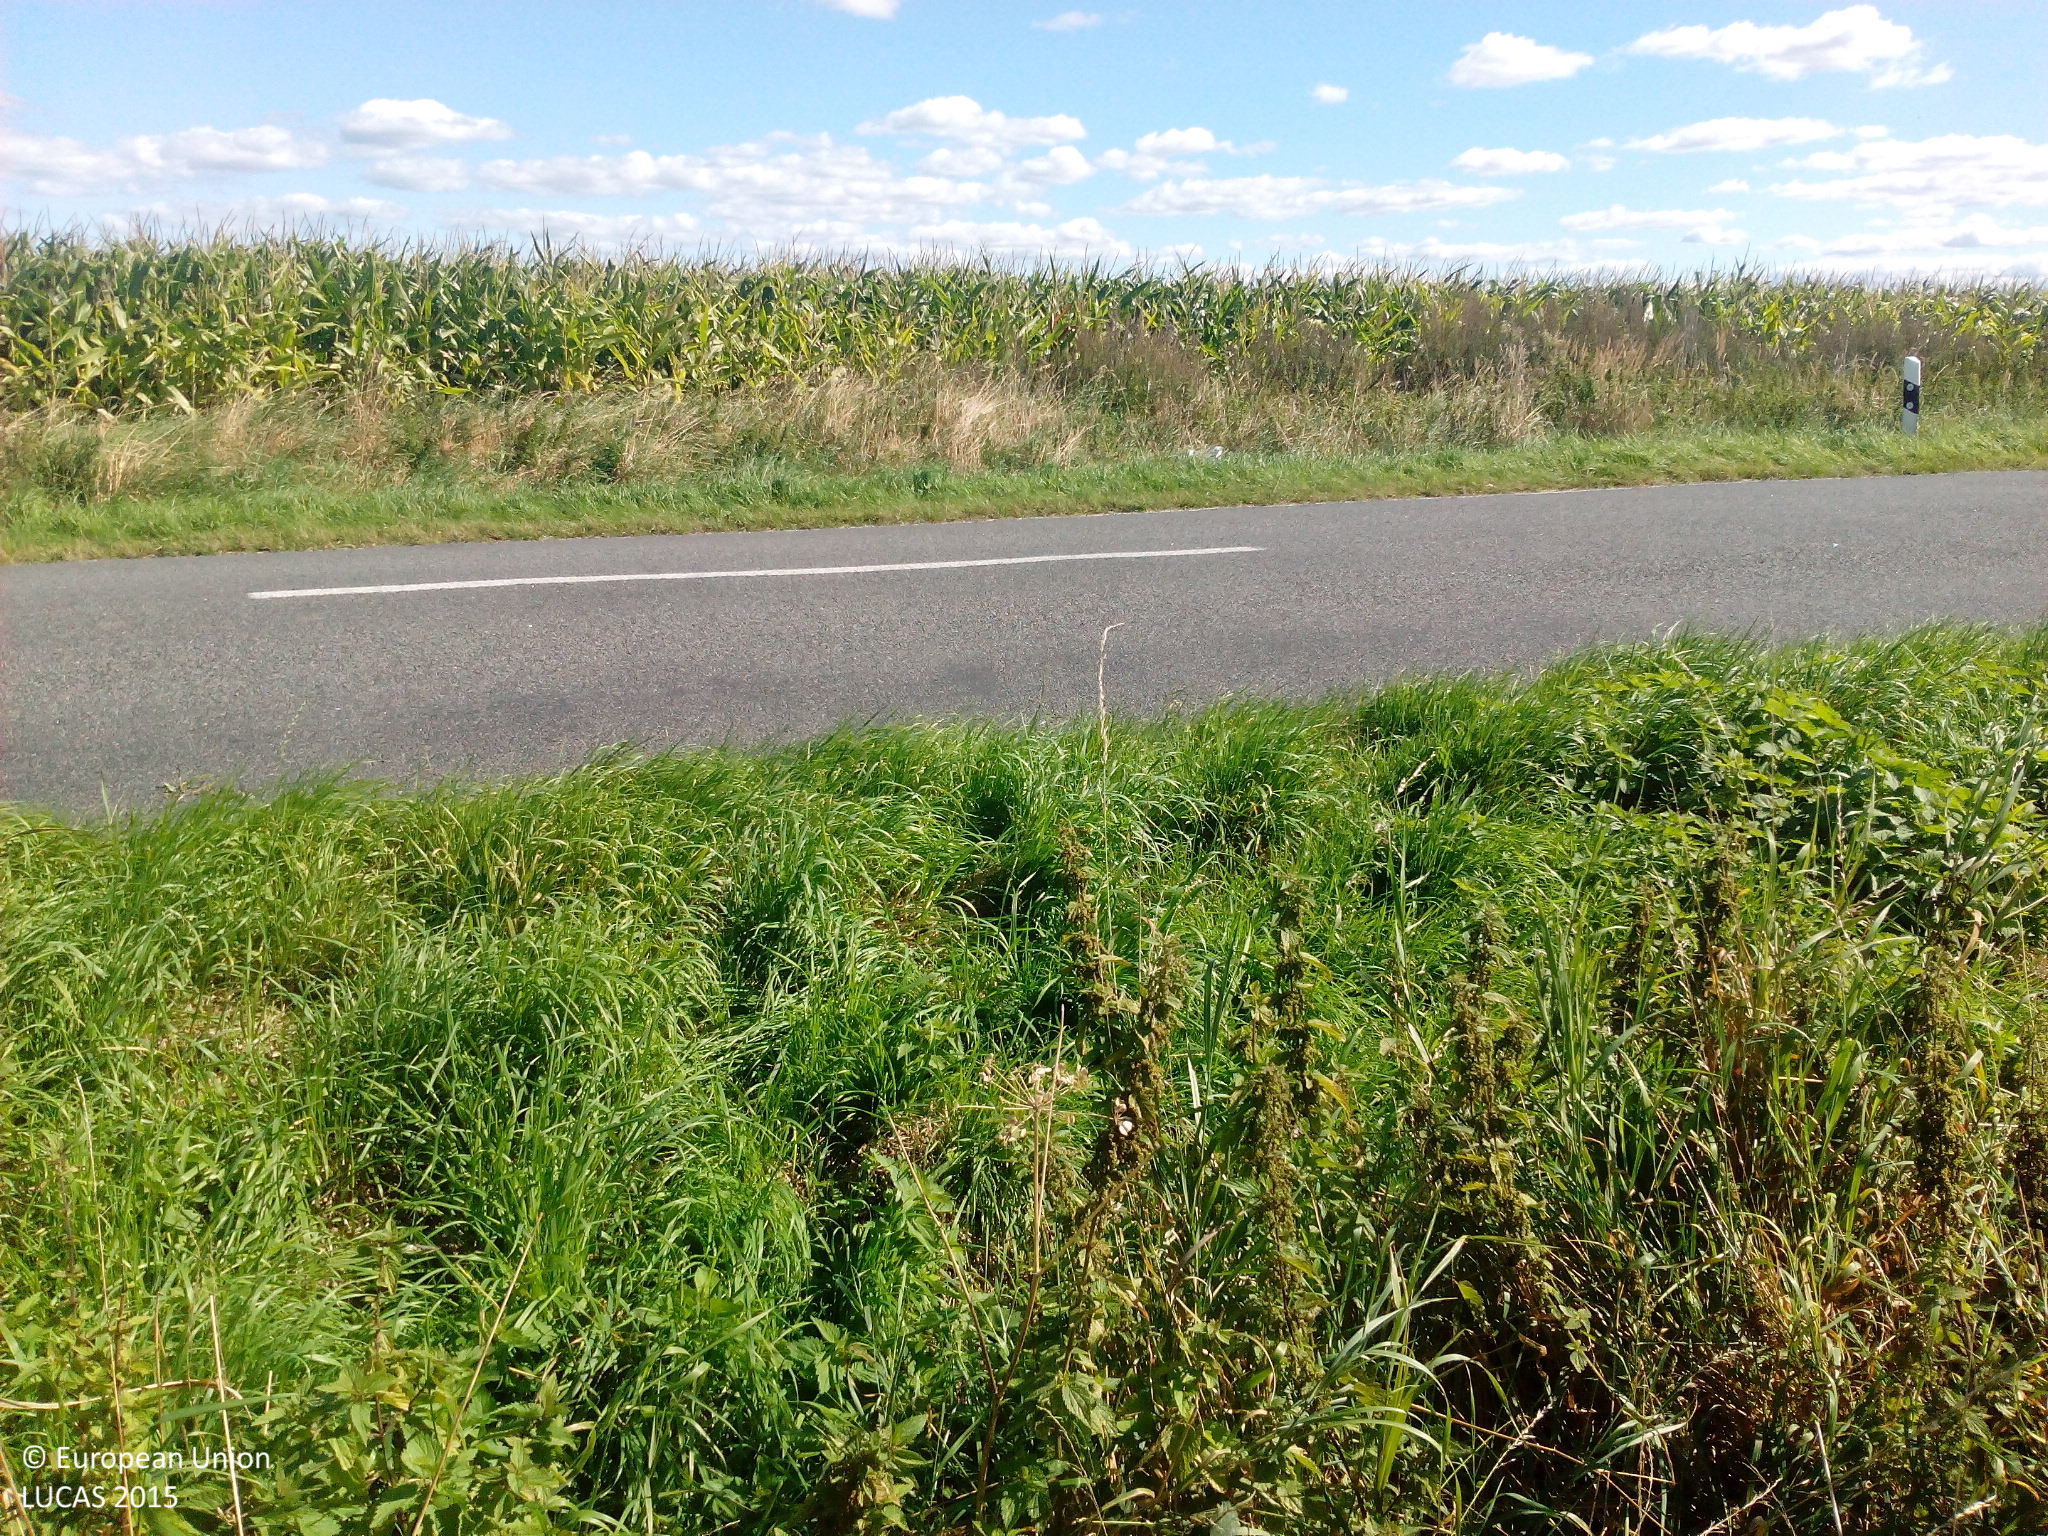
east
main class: Cropland
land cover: Maize
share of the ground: > 75 %
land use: Agriculture (excluding fallow land and kitchen gardens)
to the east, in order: Maize; Spontaneously vegetated surfaces; Grass margins; Paved roads, cycling and walking lanes; Grass margins; Spontaneously vegetated surfaces; Maize
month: September
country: DE
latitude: 54.1525
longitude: 12.3417
